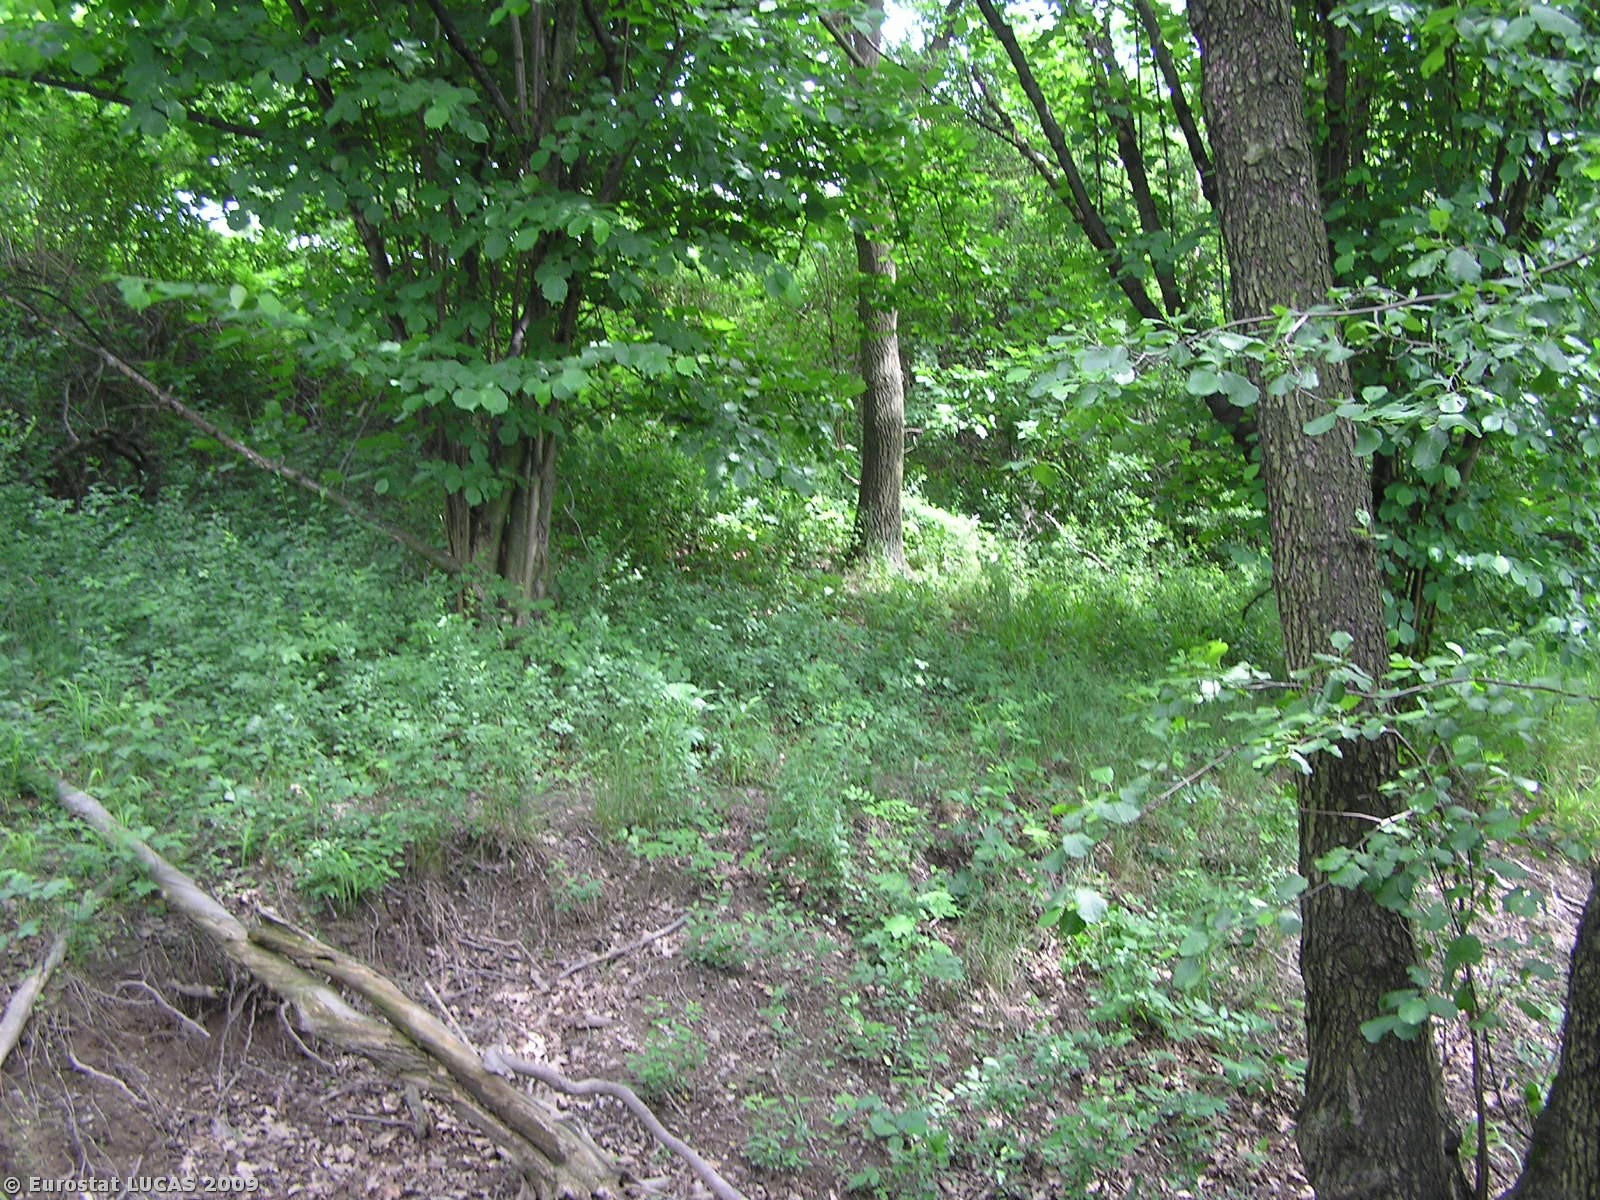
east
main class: Woodland
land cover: Broadleaved woodland
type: non-riverine alder, birch or aspen forest
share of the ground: > 75 %
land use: Unused
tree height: > 5 m
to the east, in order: Broadleaved woodland; Common wheat; Tracks; Shrubland without tree cover; Grassland without tree/shrub cover
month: June
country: CZ
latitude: 50.1802
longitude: 17.6454
